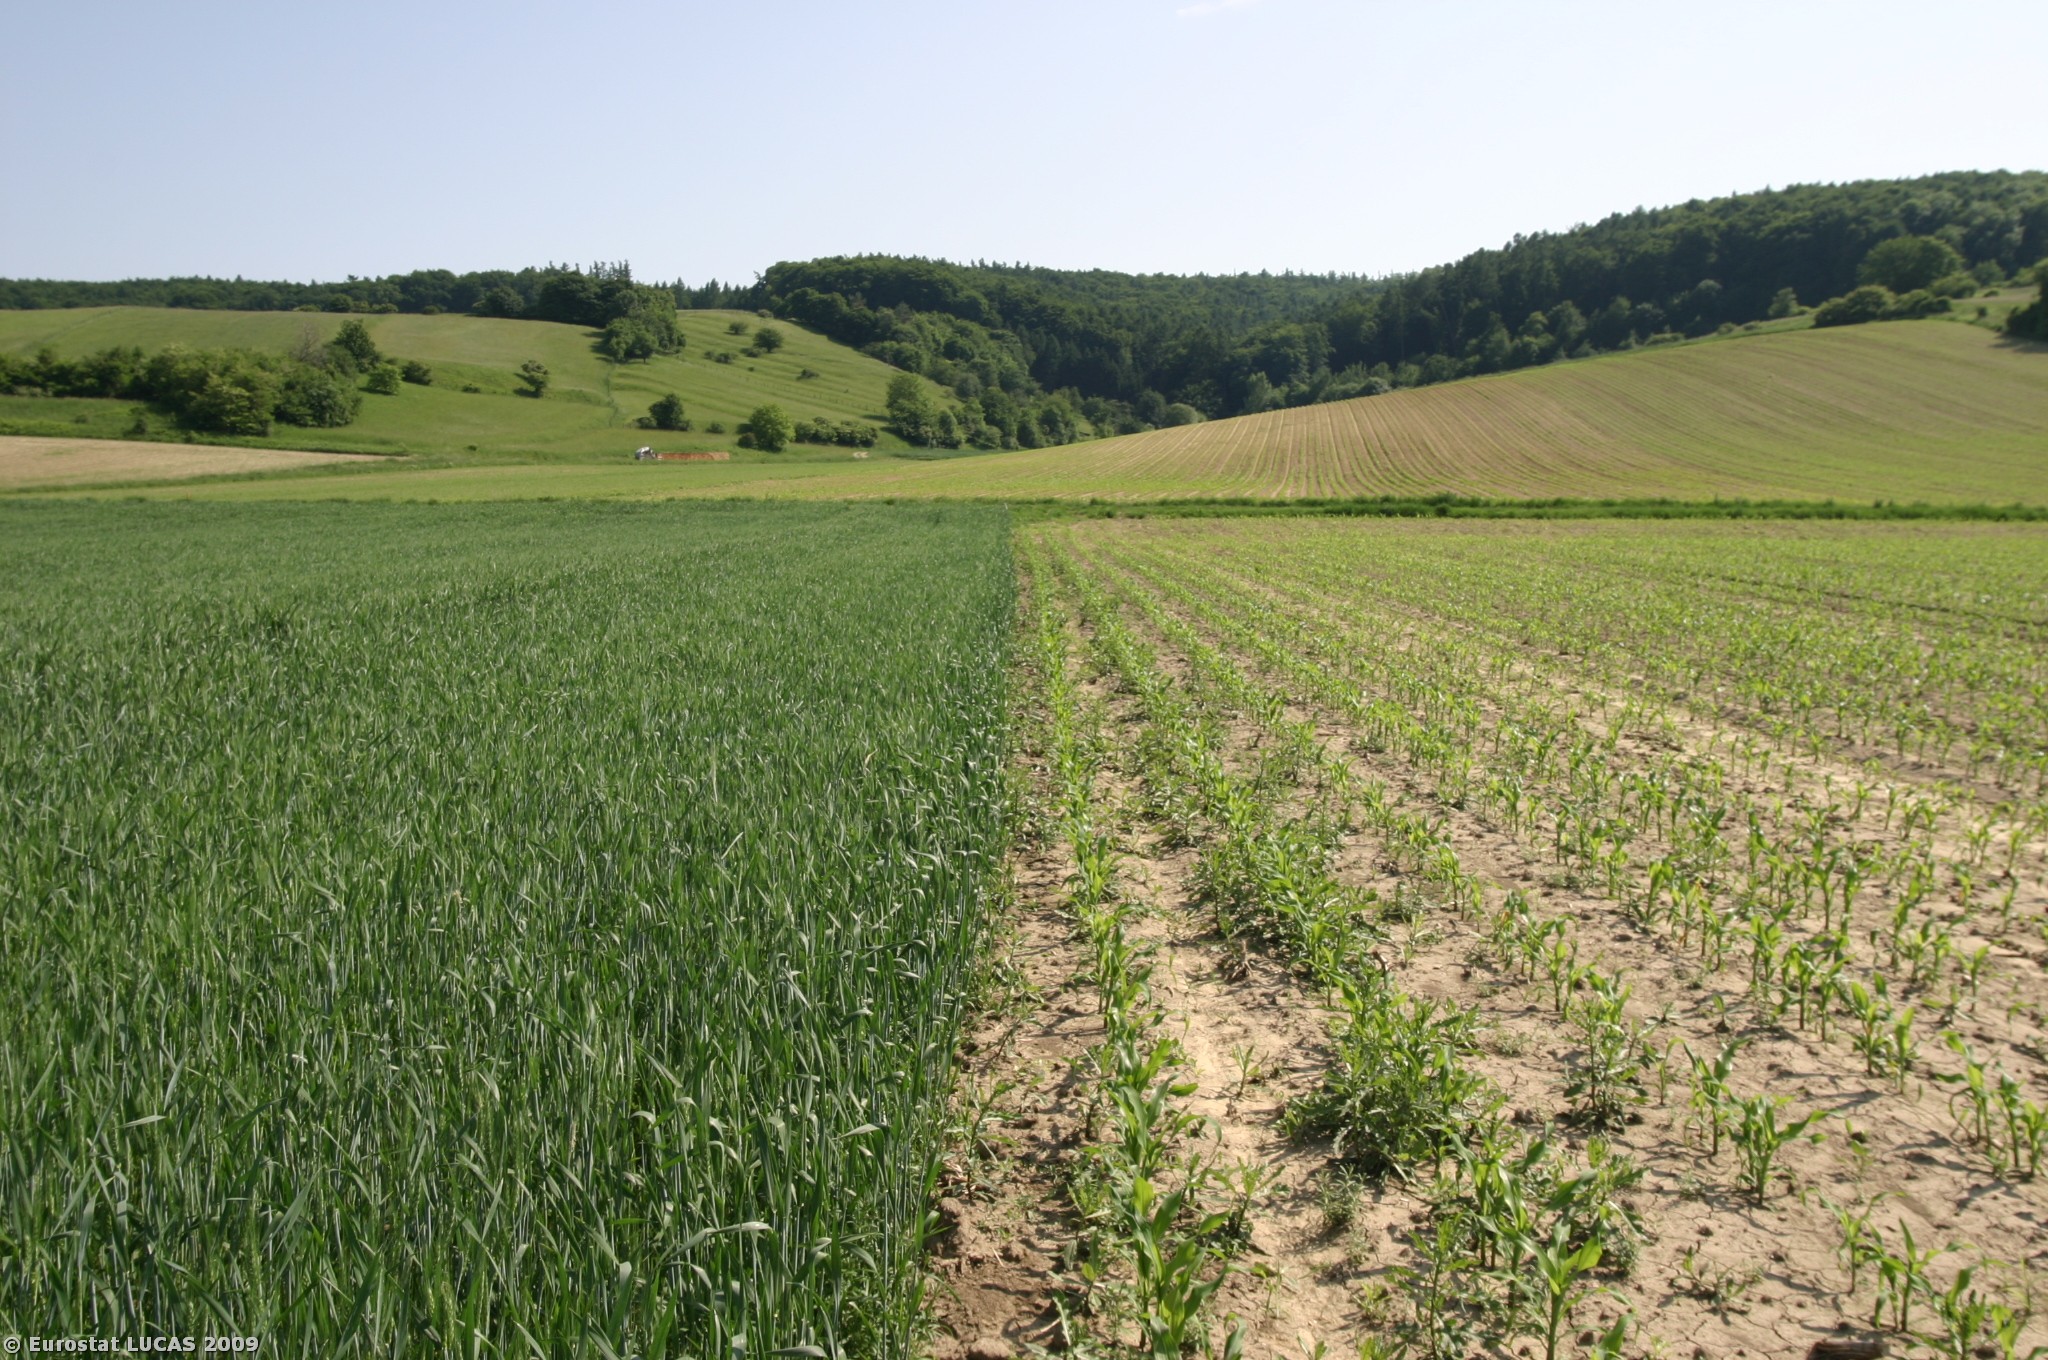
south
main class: Cropland
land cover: Common wheat
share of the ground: > 75 %
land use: Agriculture (excluding fallow land and kitchen gardens)
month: May
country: AT
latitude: 48.2602
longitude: 15.9711
